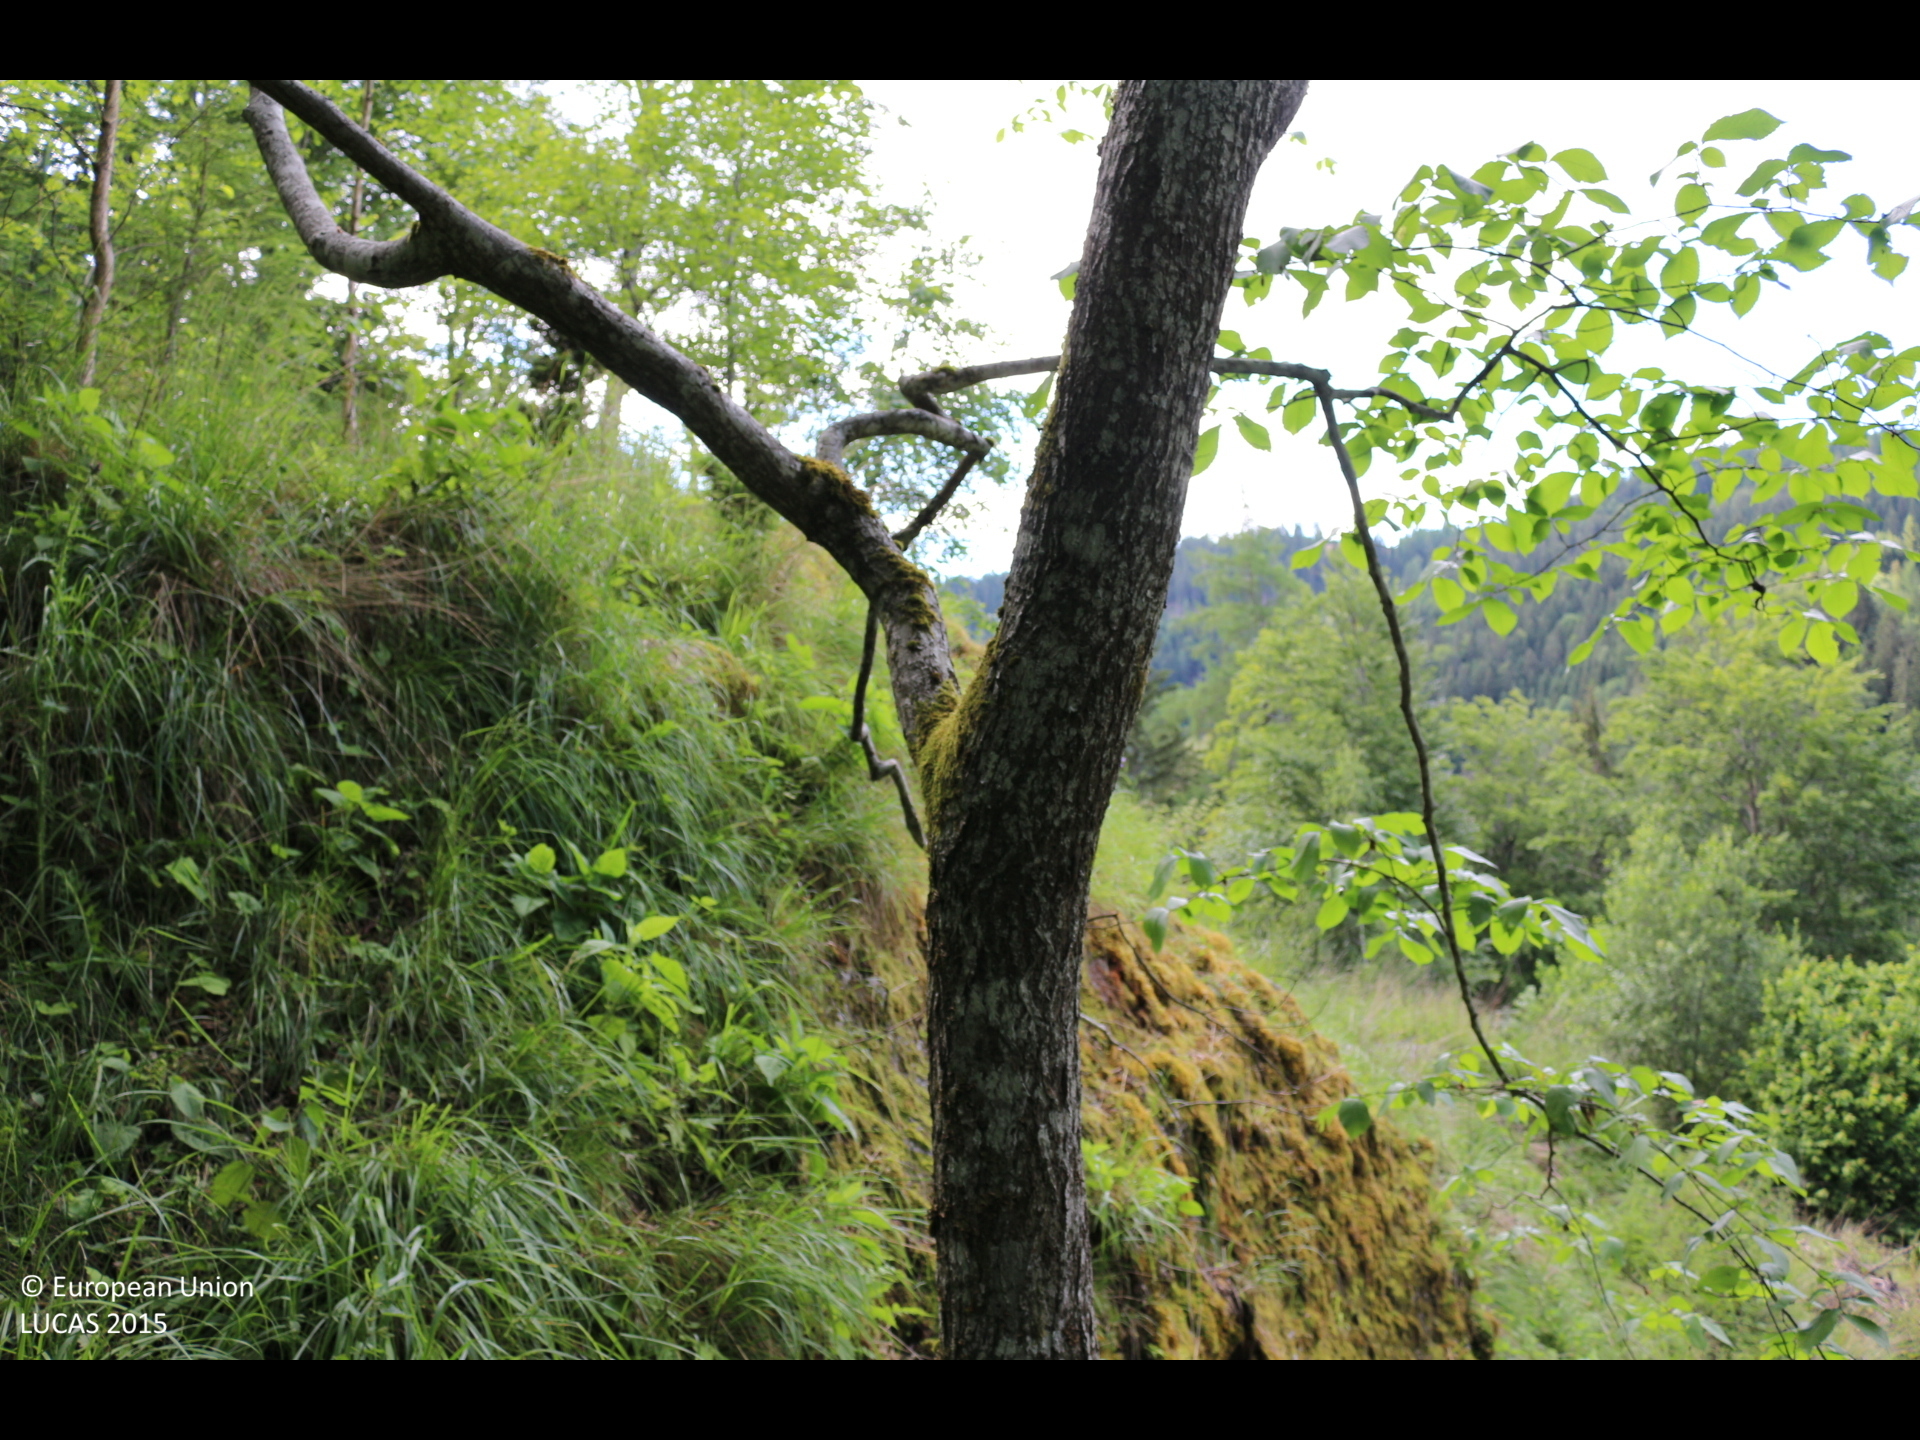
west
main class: Woodland
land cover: Broadleaved woodland
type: mountainous beech forest
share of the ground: > 75 %
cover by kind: broadleaved forest trees 90 %, coniferous forest trees 10 %
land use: Forestry
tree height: > 5 m
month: June
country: AT
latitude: 46.8404
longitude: 14.3380
